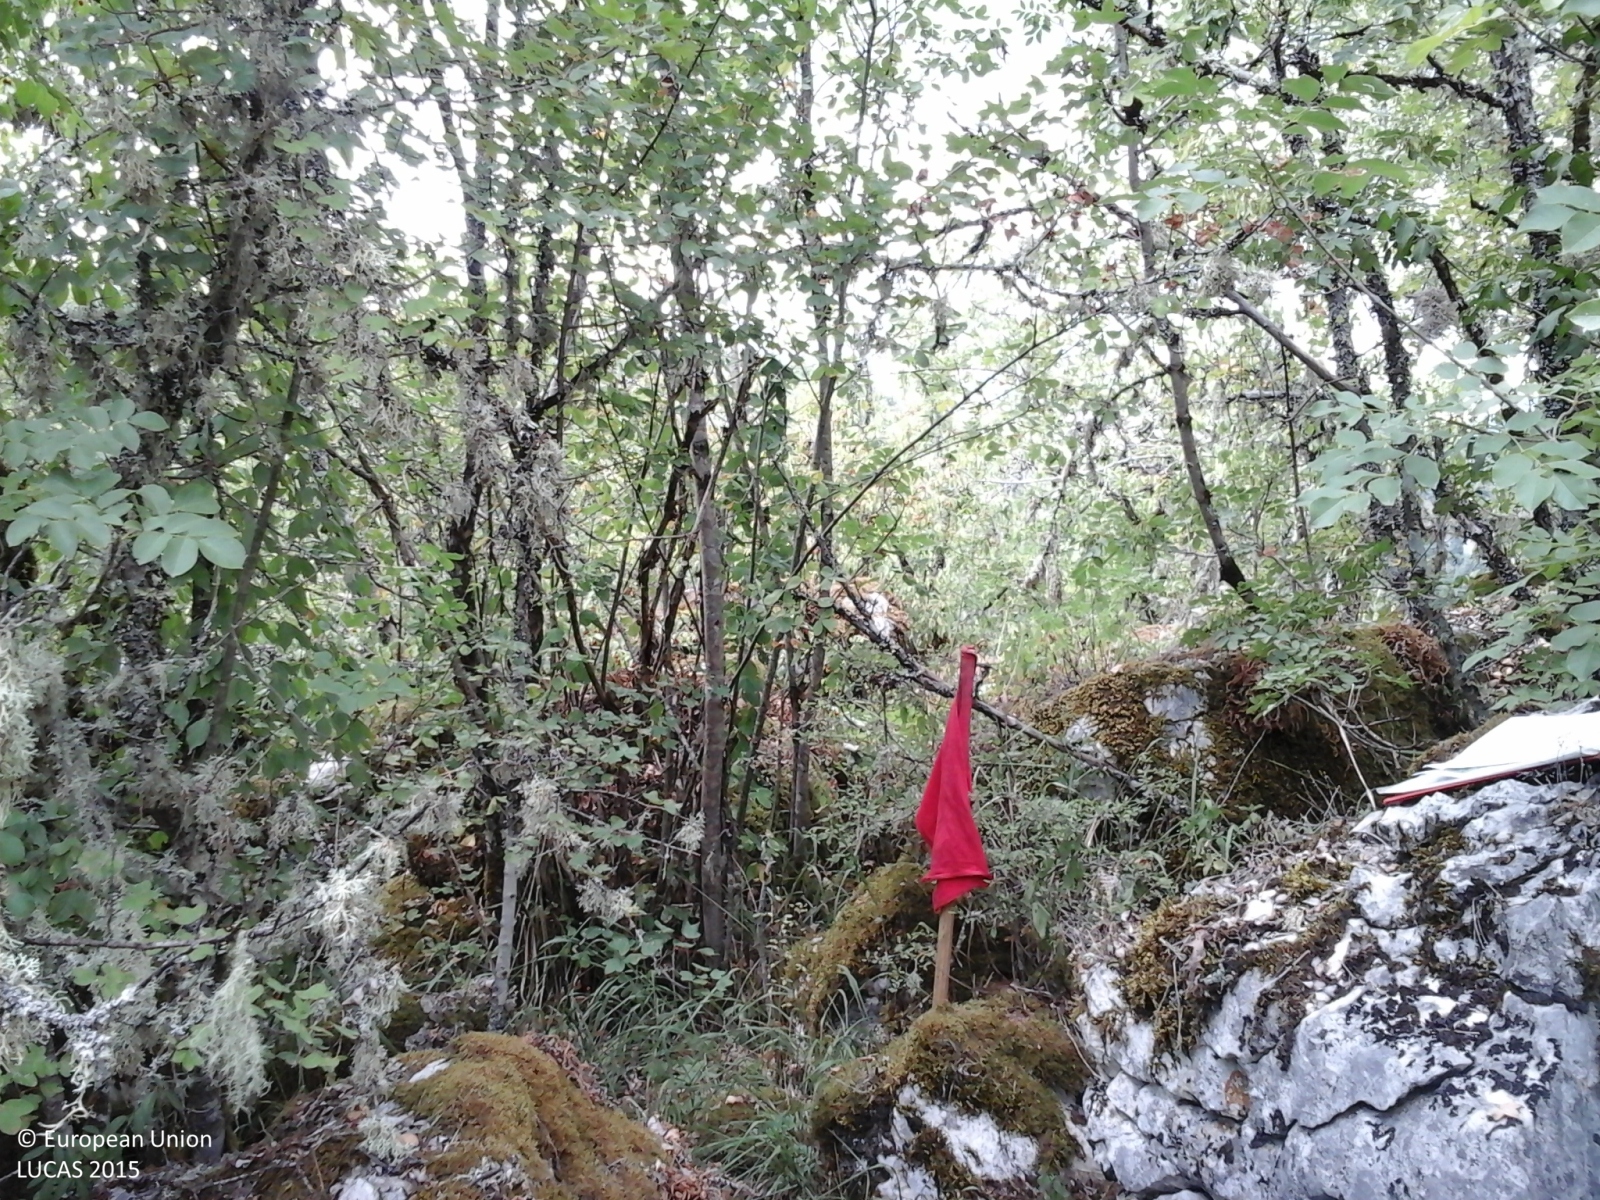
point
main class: Woodland
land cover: Broadleaved woodland
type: thermophilous deciduous forest
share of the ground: > 75 %
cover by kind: broadleaved forest trees 90 %, shrubs 5 %, herbaceous plants 5 %
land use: Semi-natural and natural areas not in use
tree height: < 5 m
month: August
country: IT
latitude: 42.2254
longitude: 13.1516
